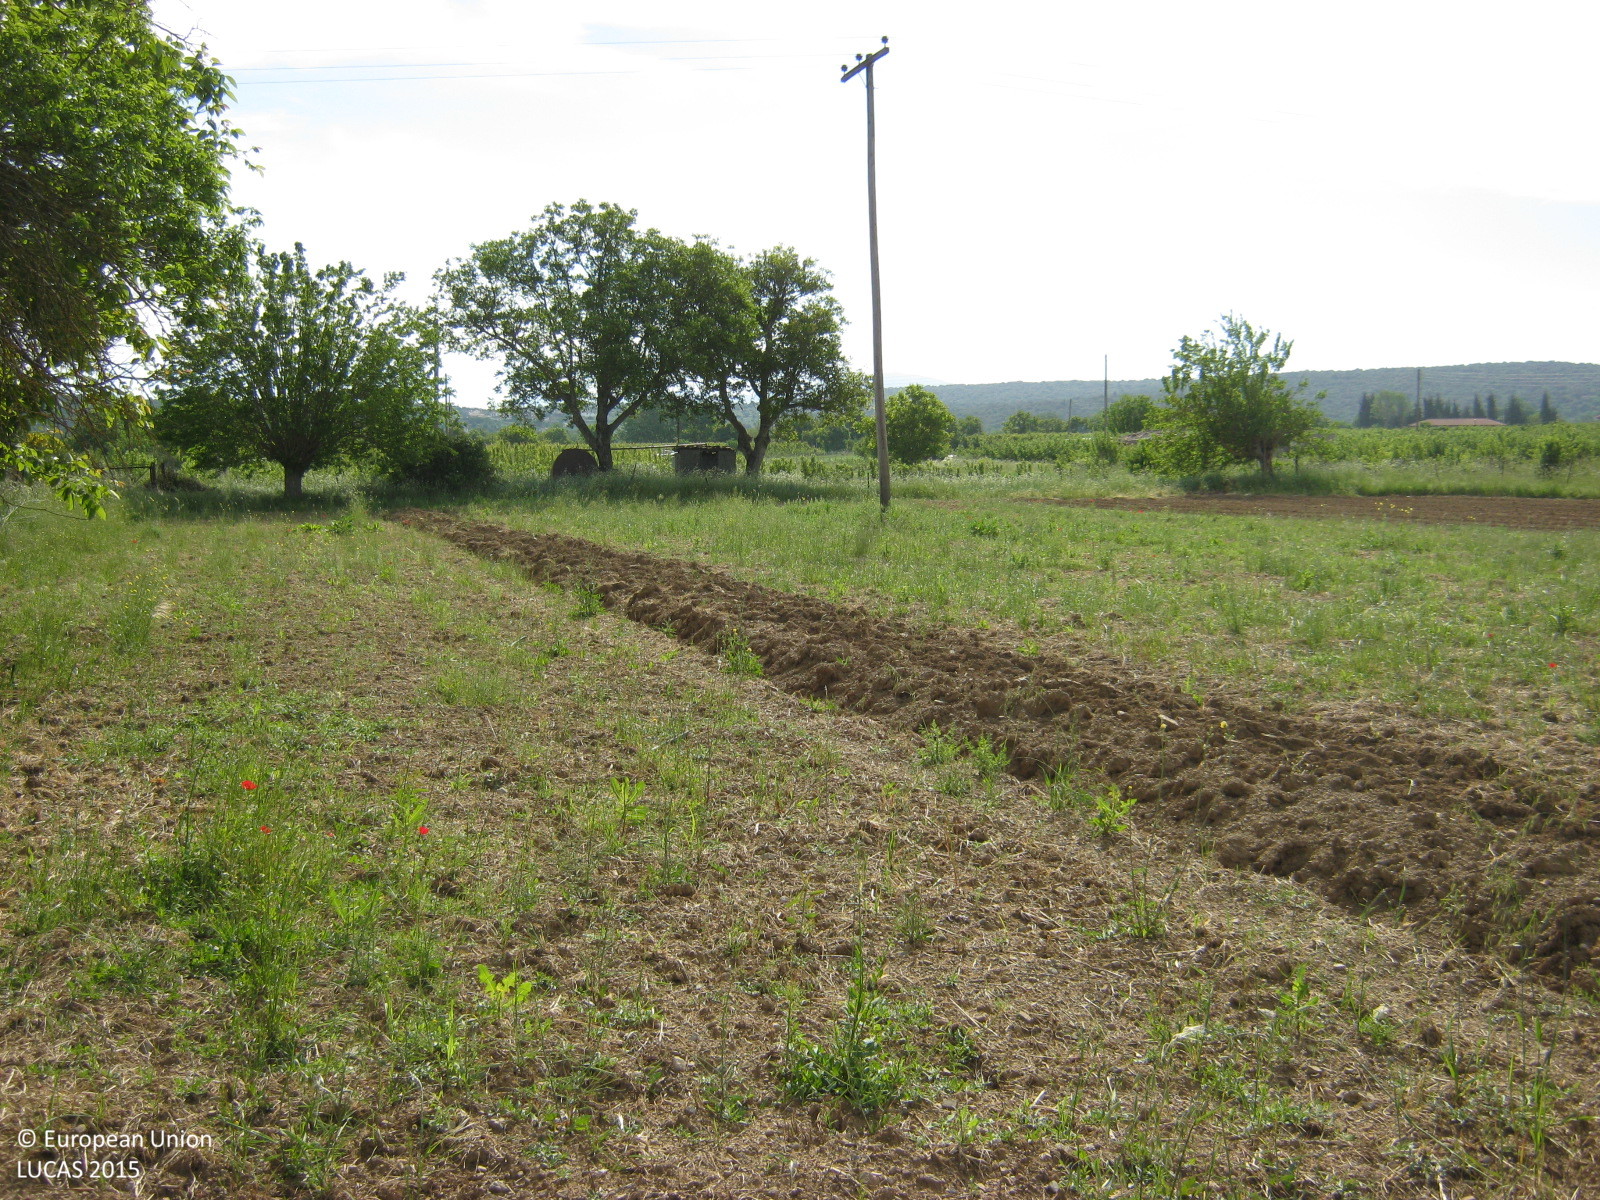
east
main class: Grassland
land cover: Spontaneously vegetated surfaces
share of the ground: > 75 %
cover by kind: herbaceous plants 50 %, unconsolidated bare surface 50 %
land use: Abandoned areas
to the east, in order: Spontaneously vegetated surfaces; Electric lines; Spontaneously vegetated surfaces; Fences; Apple fruit; Grass margins; Ditches and canals; Spontaneously vegetated surfaces; Tracks; Ditches and canals; Fences; Maize; Oats
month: May
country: GR
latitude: 37.4537
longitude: 22.3393
